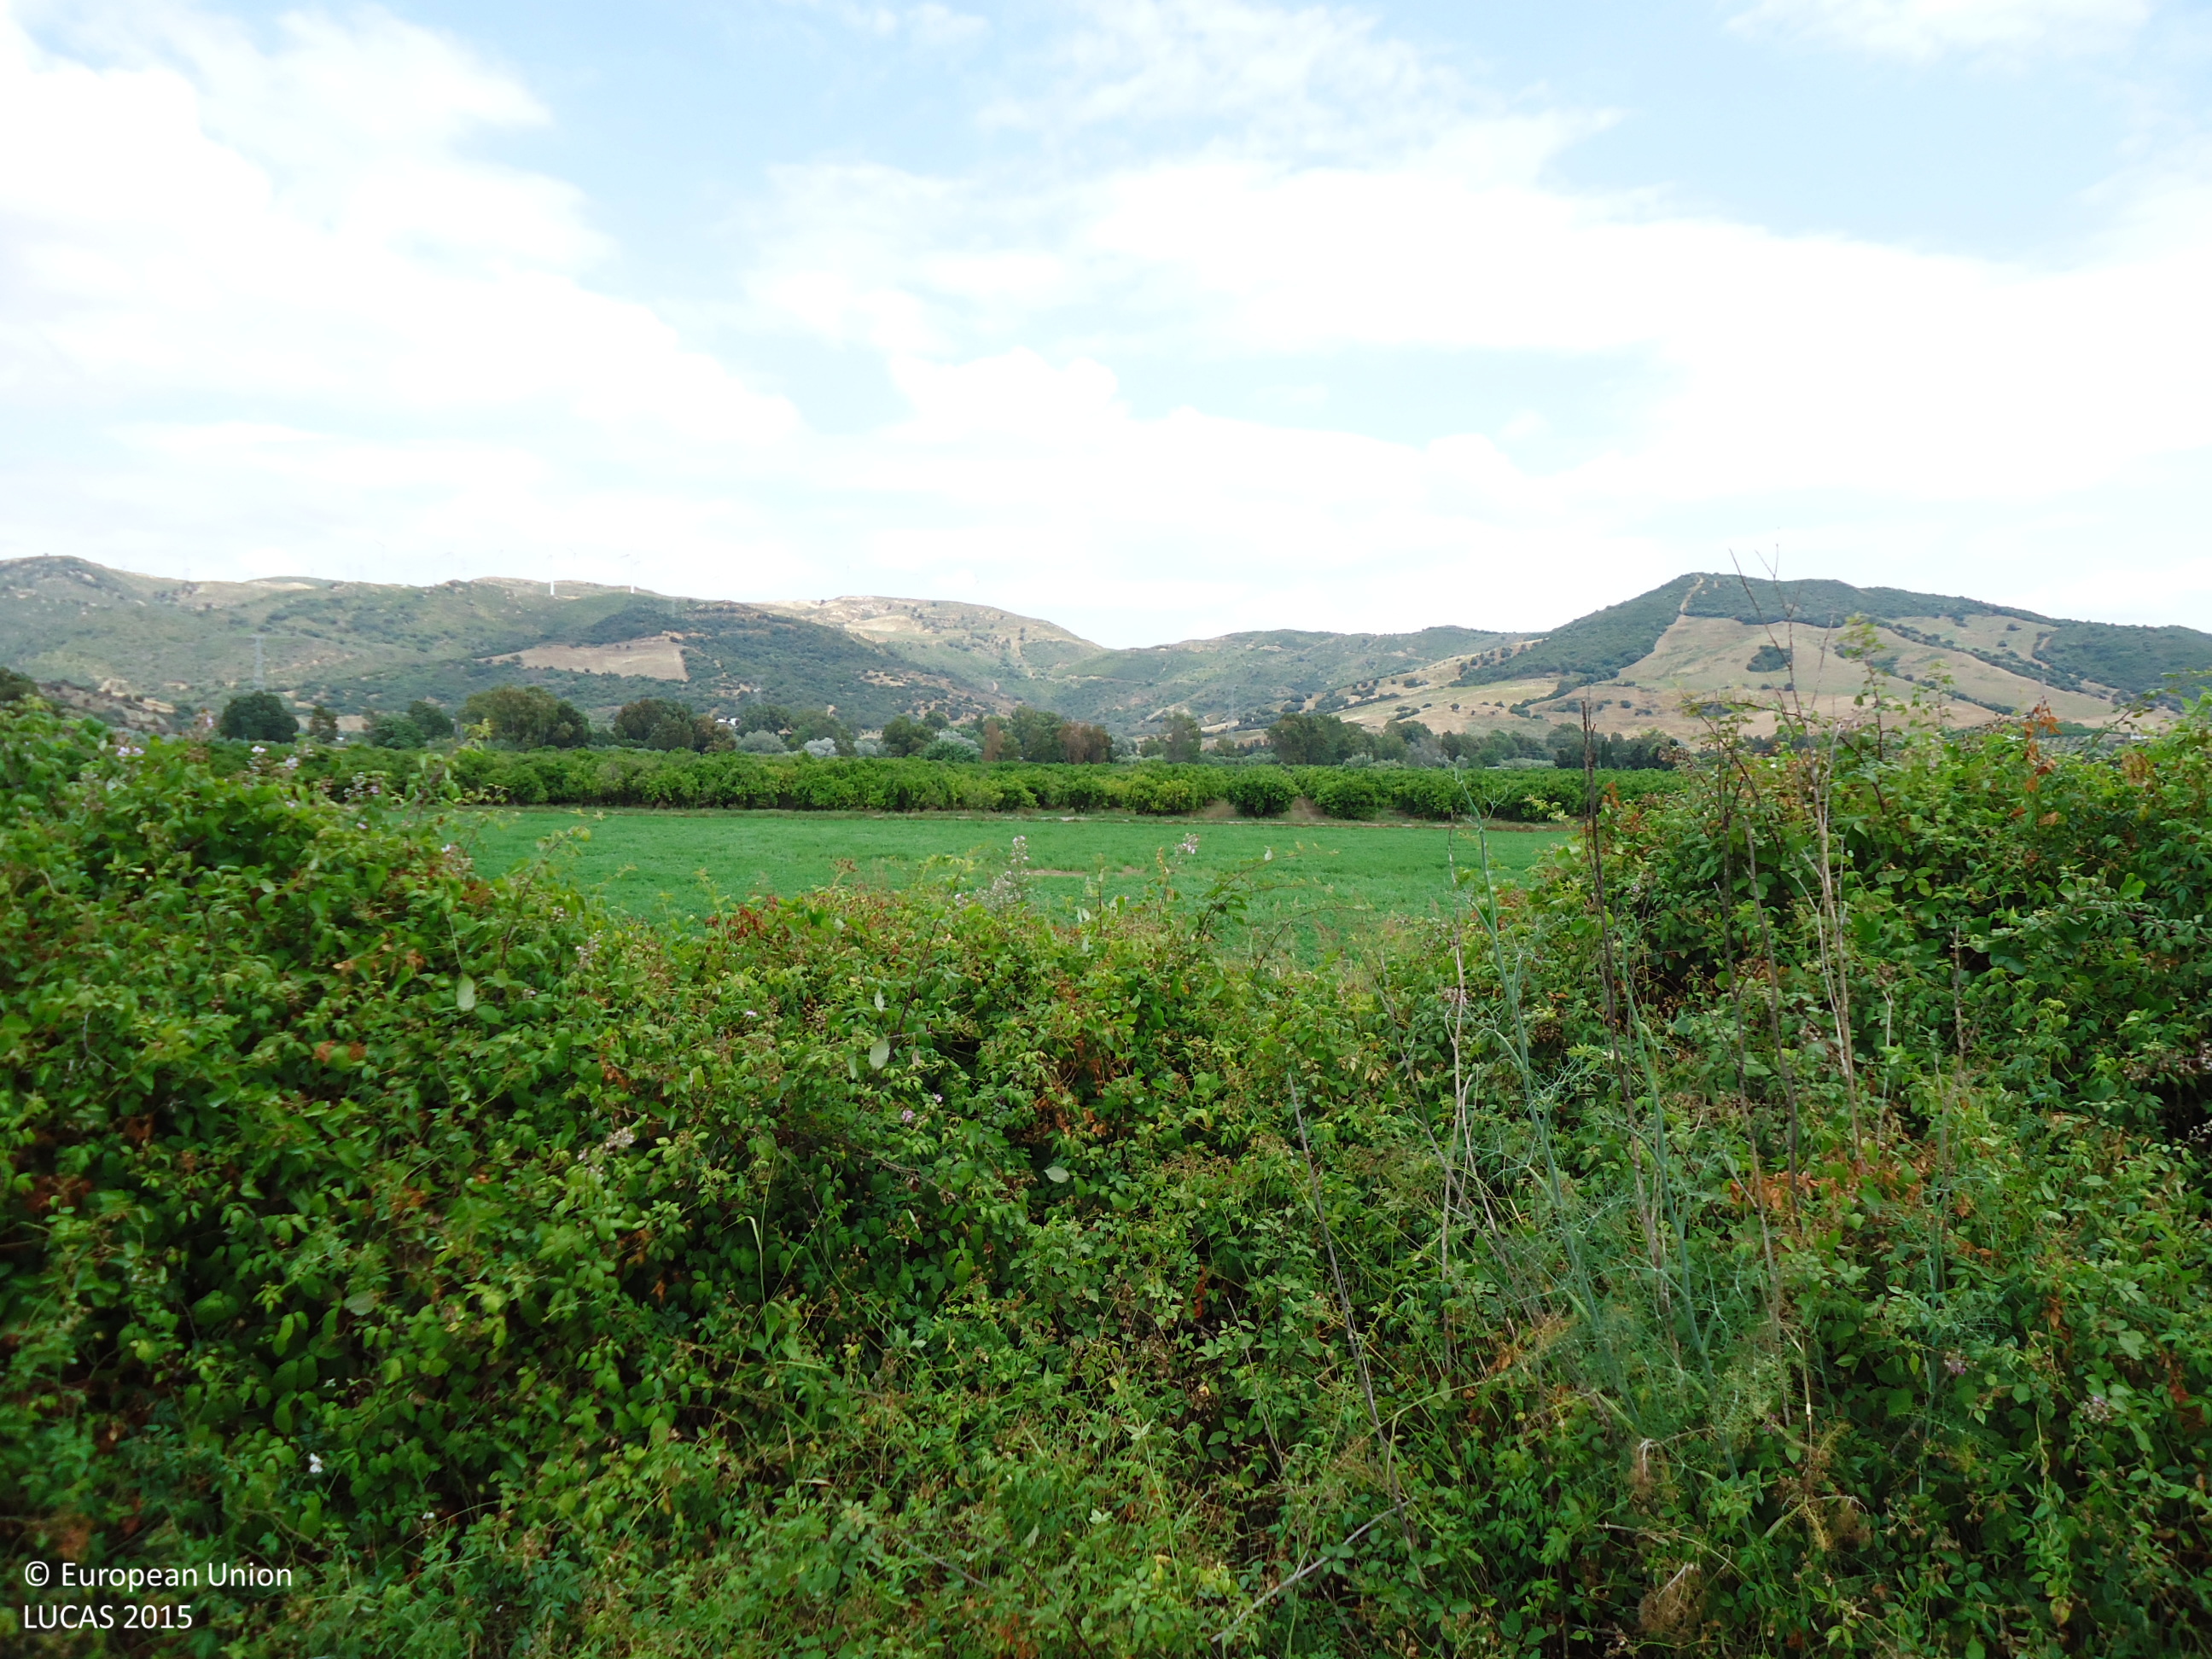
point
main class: Cropland
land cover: Lucerne
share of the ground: > 75 %
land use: Agriculture (excluding fallow land and kitchen gardens)
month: June
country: ES
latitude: 36.3693
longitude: -5.3194
